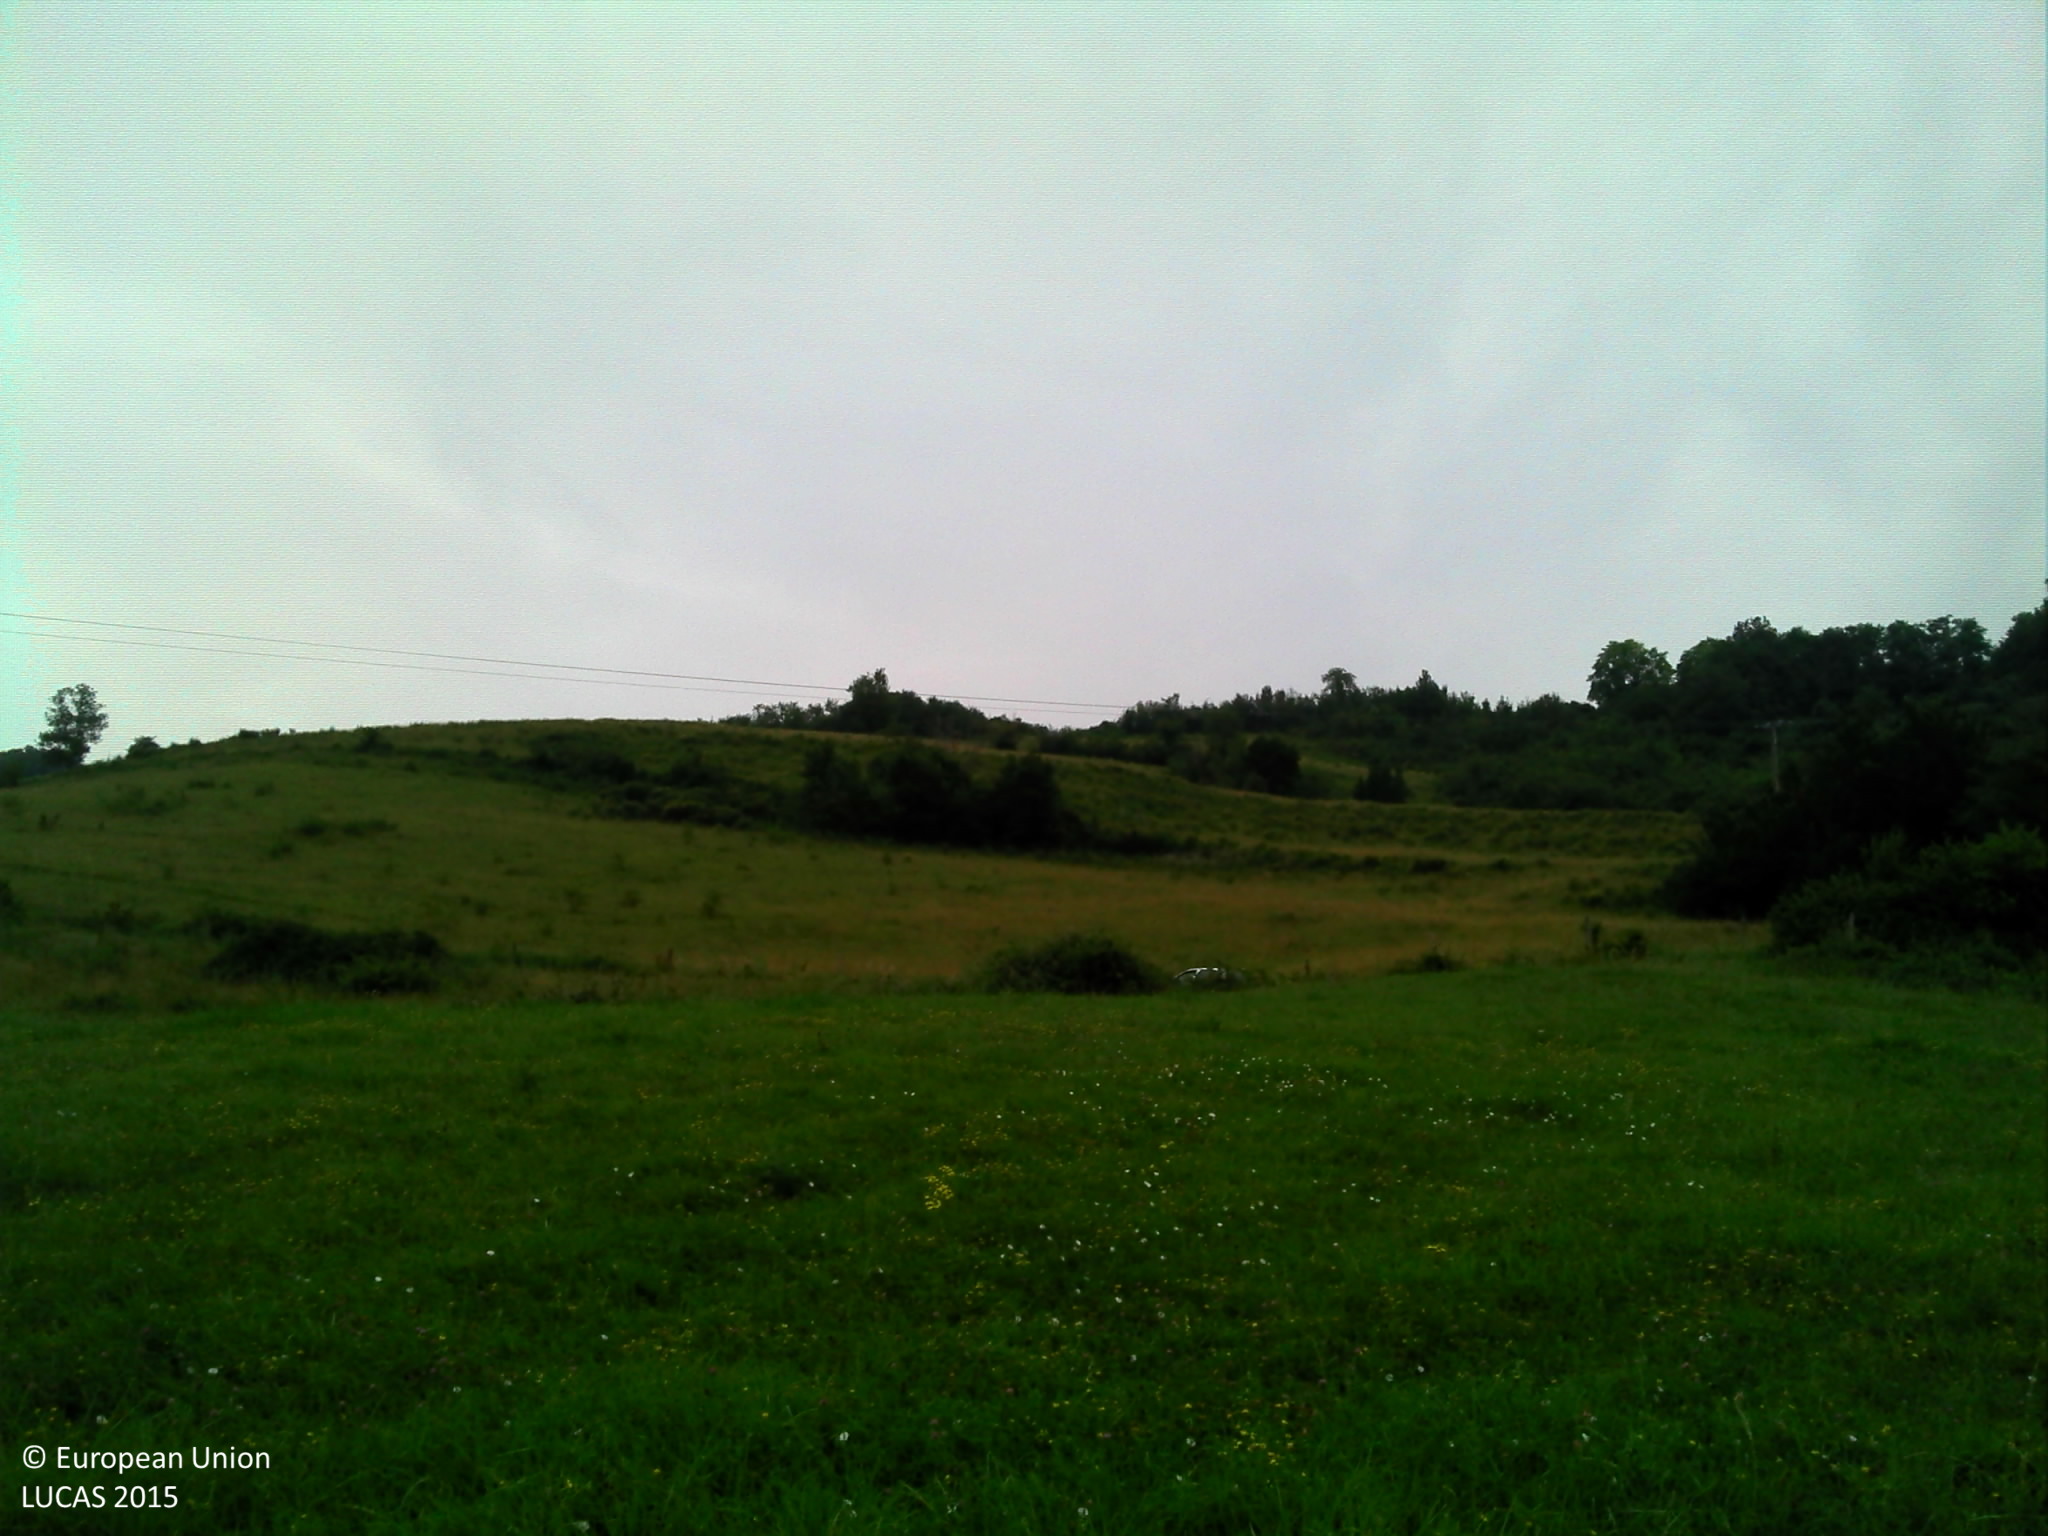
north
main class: Grassland
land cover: Grassland without tree/shrub cover
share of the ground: > 75 %
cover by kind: herbaceous plants 100 %
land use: Agriculture (excluding fallow land and kitchen gardens)
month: July
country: FR
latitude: 43.1036
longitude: 1.3917
